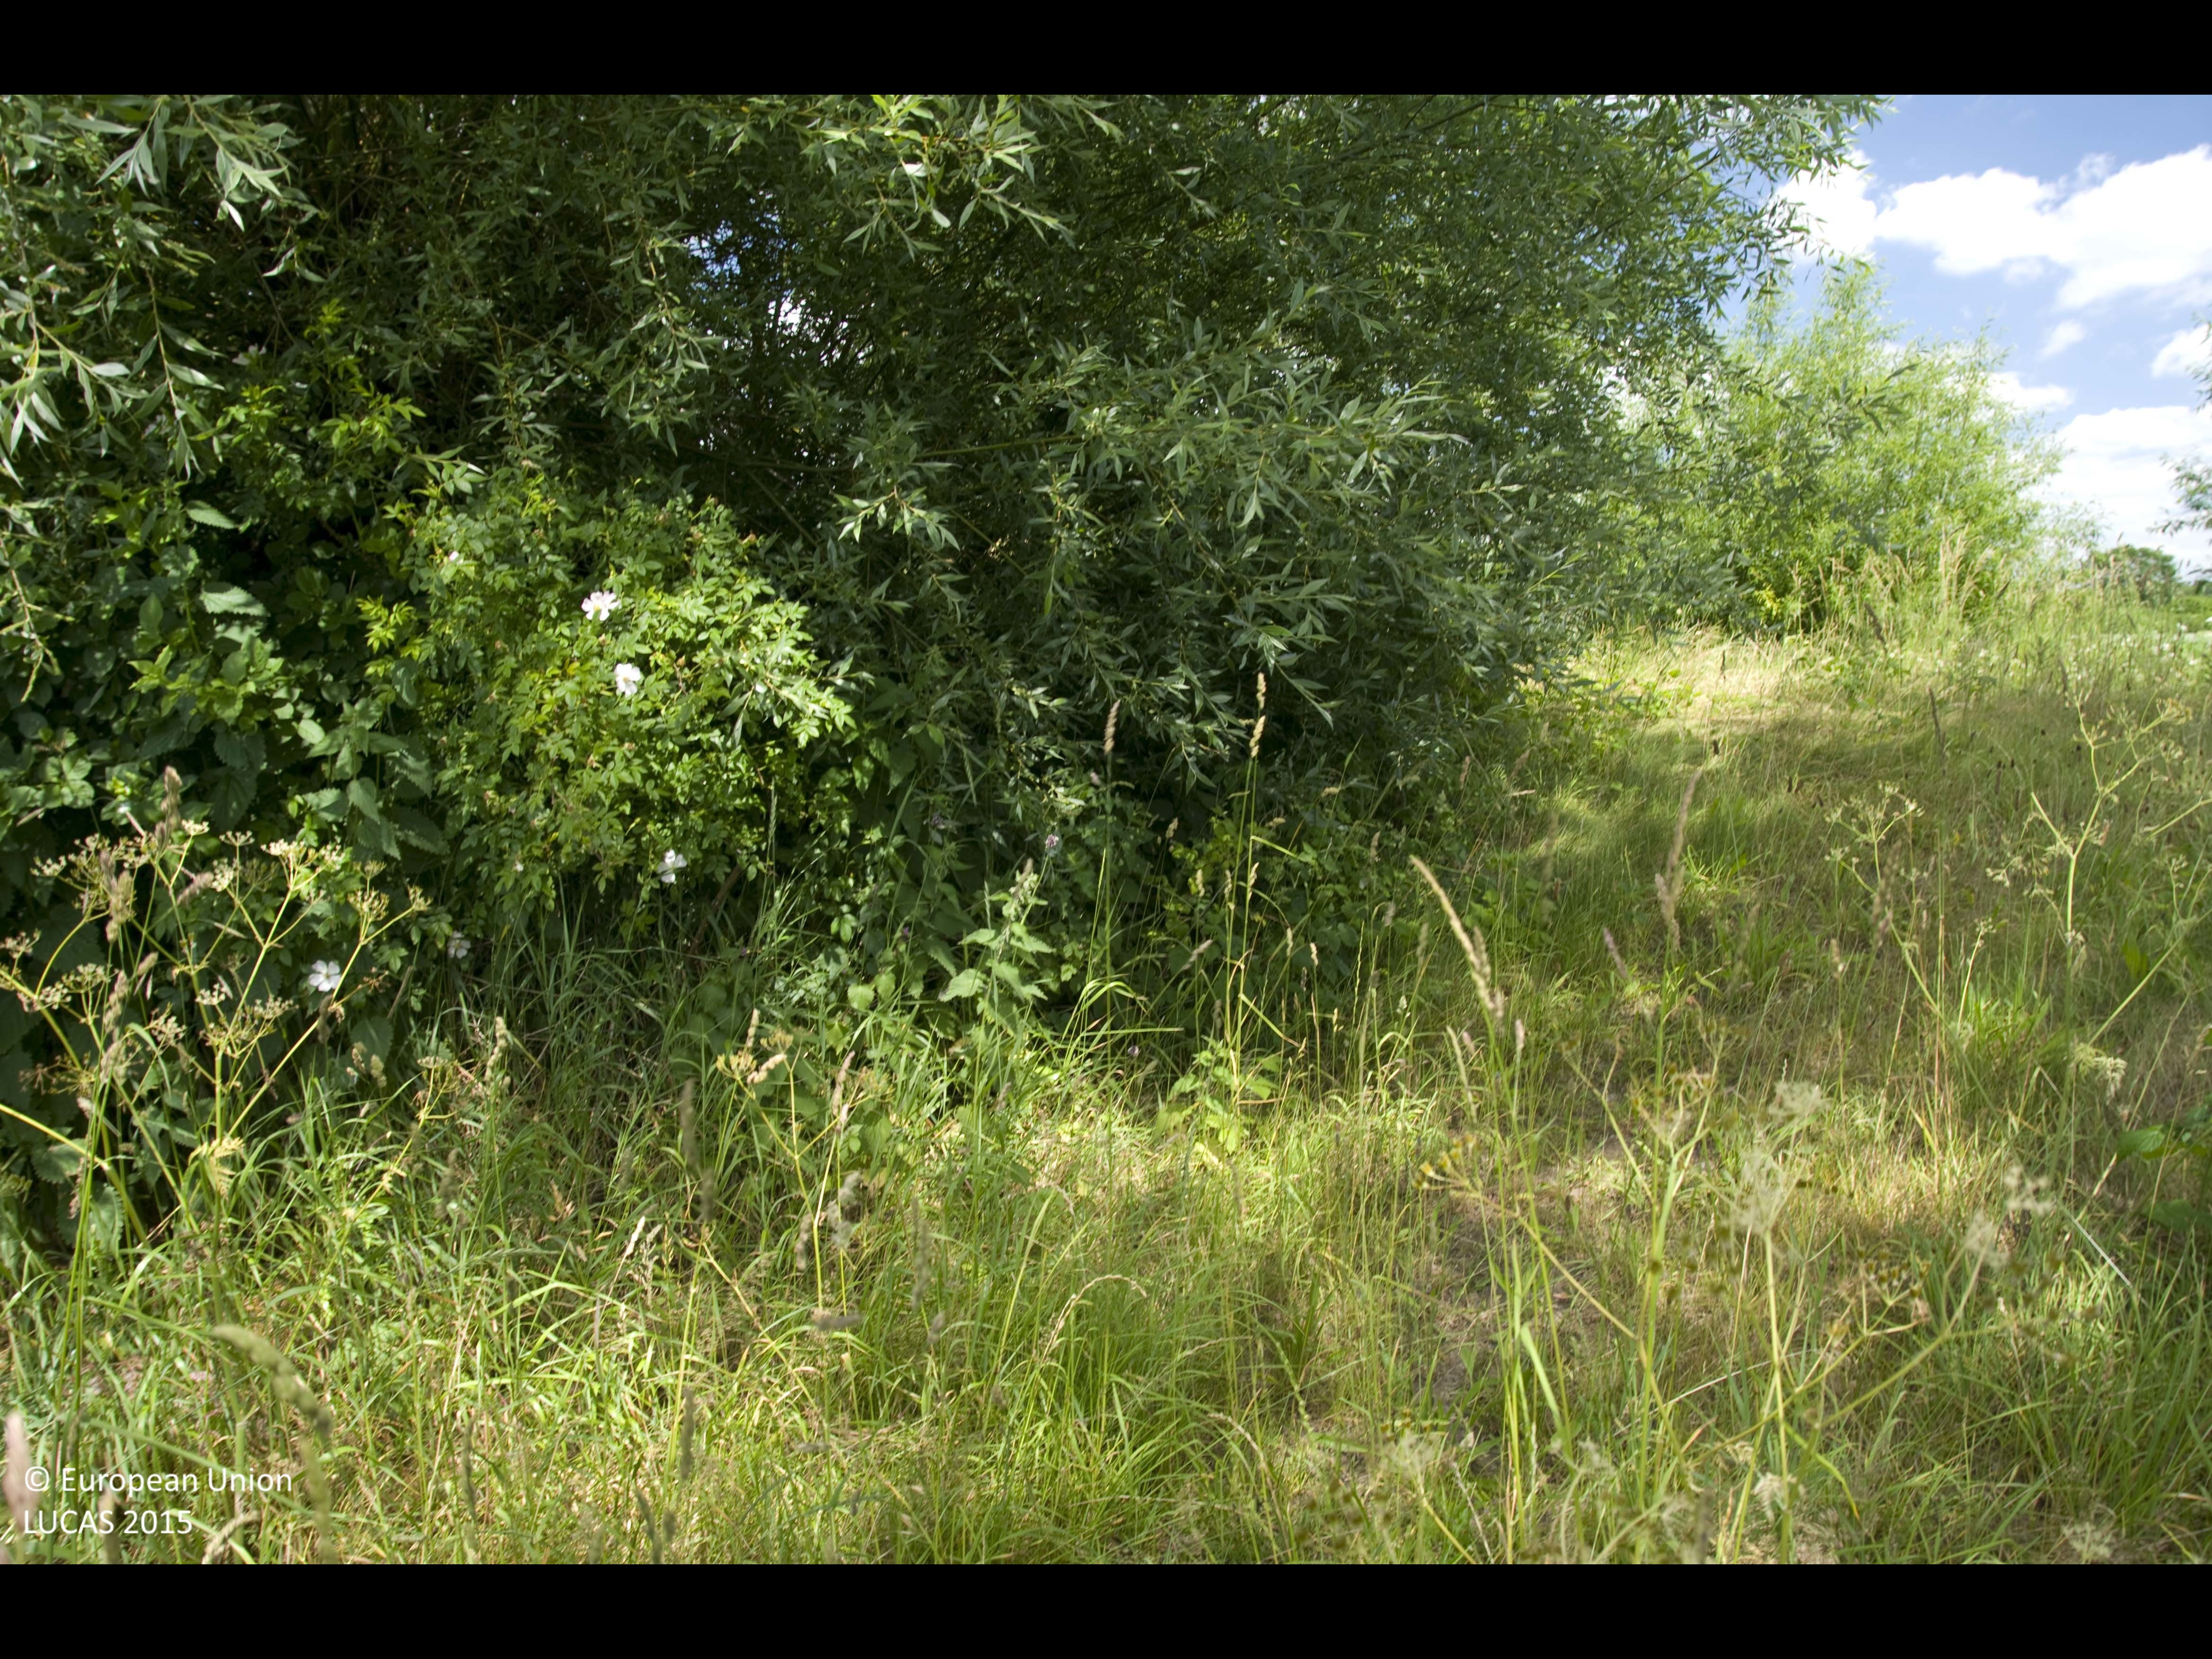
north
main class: Cropland
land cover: Rape and turnip rape
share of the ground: > 75 %
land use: Agriculture (excluding fallow land and kitchen gardens)
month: June
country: DE
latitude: 53.6340
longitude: 10.6197
